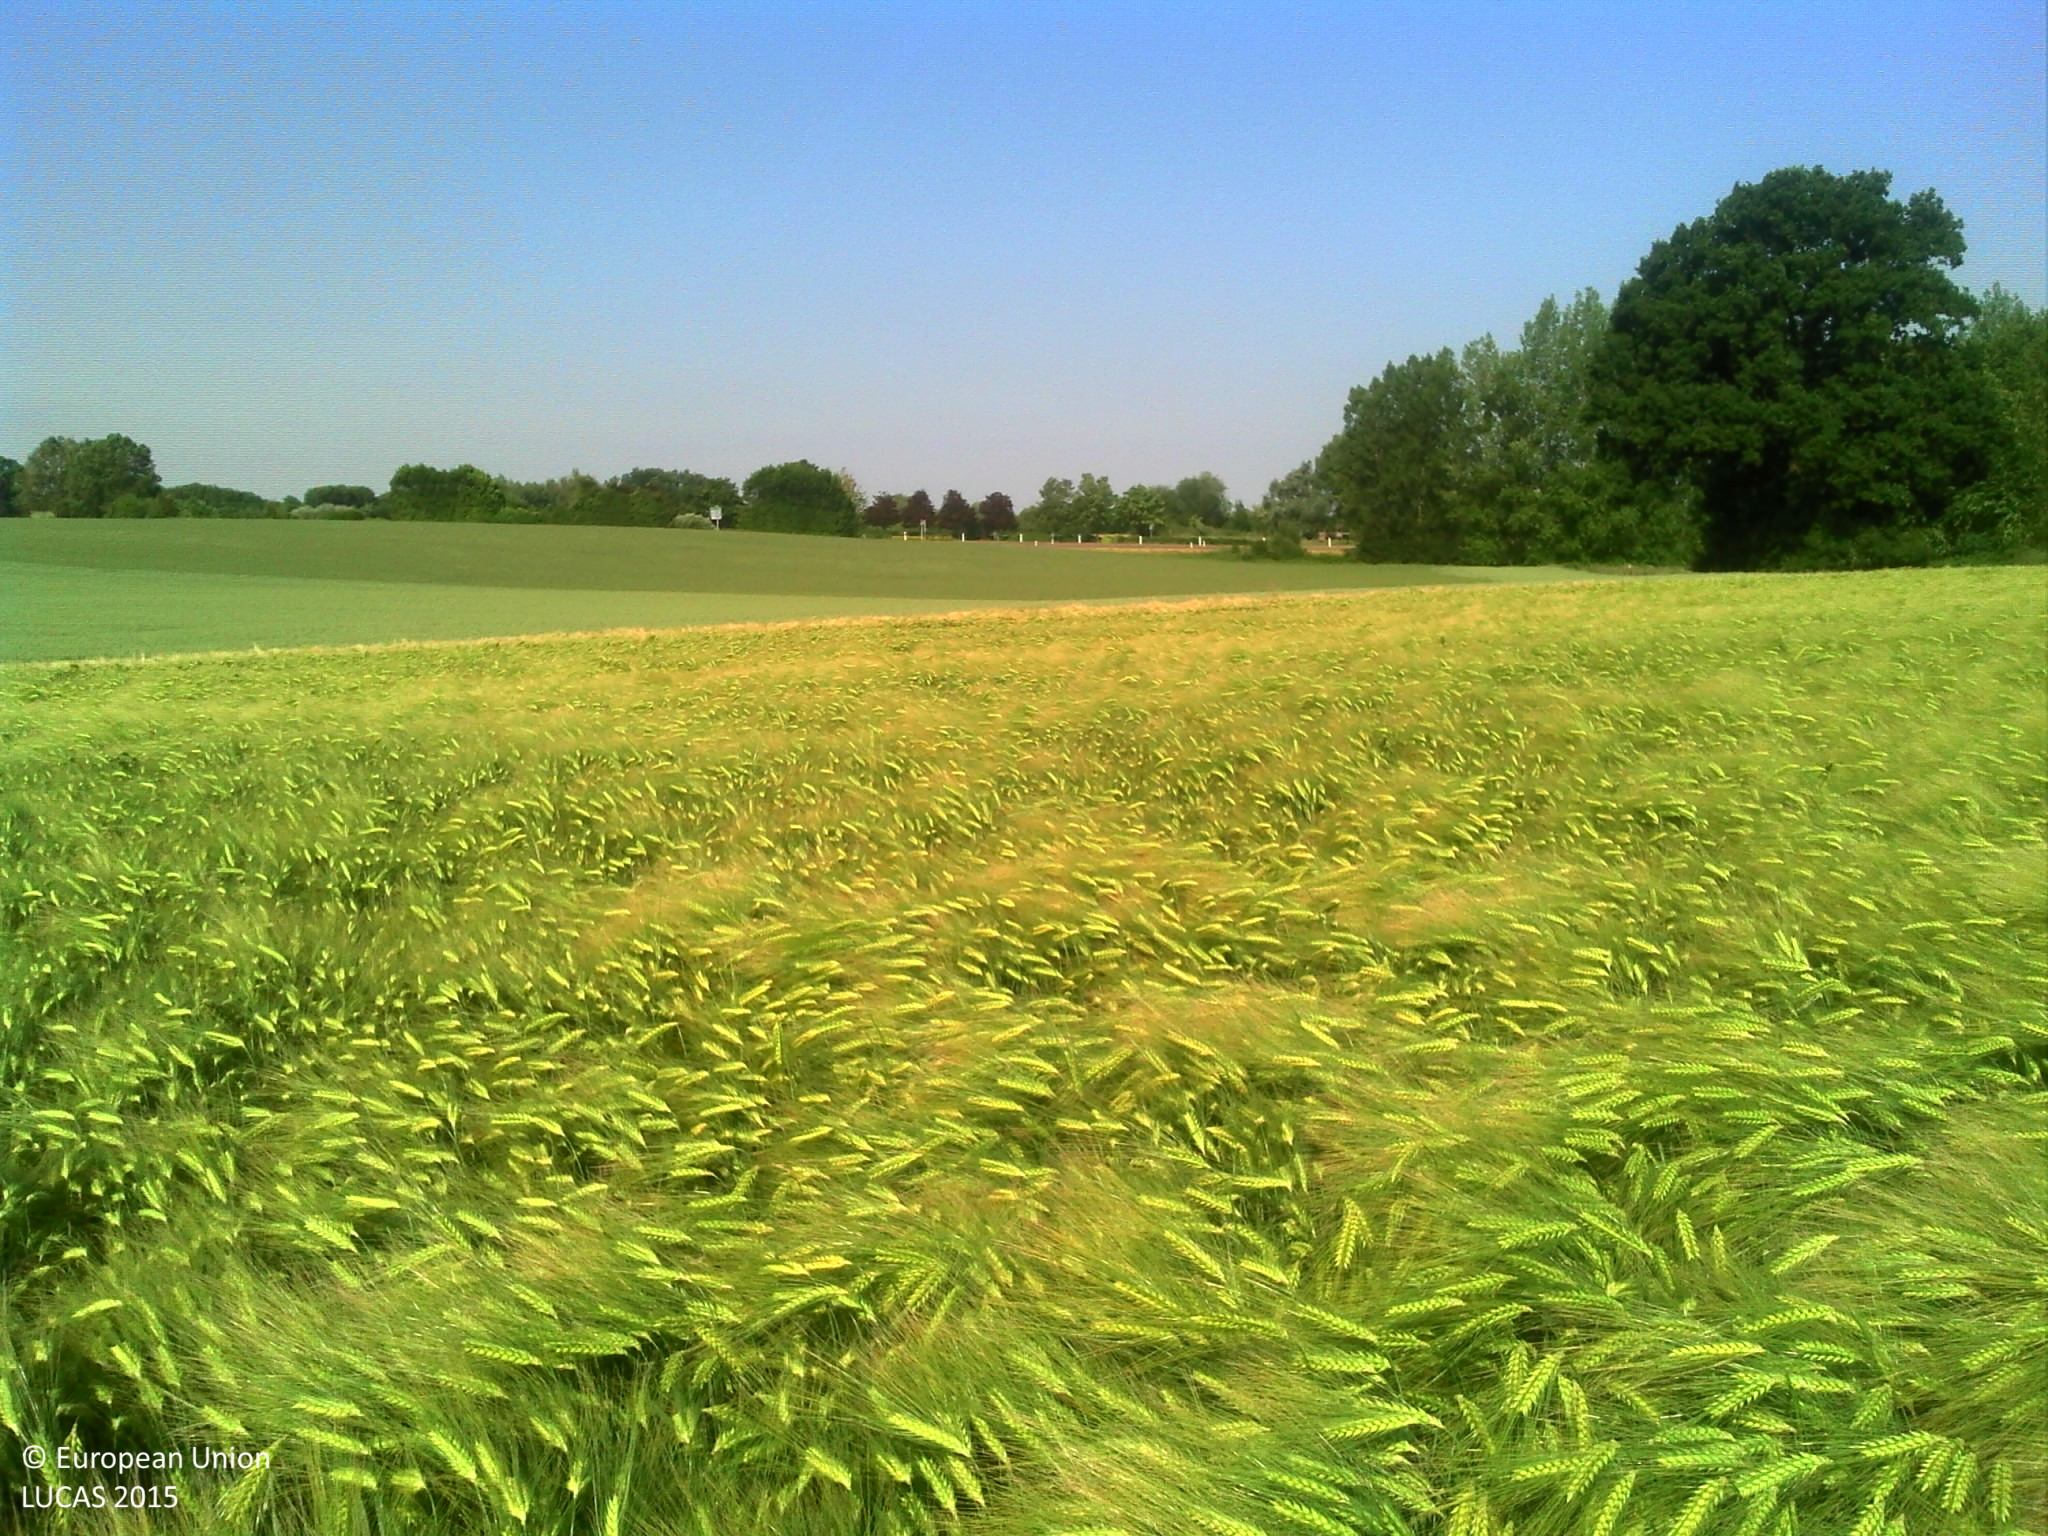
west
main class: Cropland
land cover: Barley
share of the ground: > 75 %
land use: Agriculture (excluding fallow land and kitchen gardens)
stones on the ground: < 10 %
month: June
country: FR
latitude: 49.8833
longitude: 4.0240
